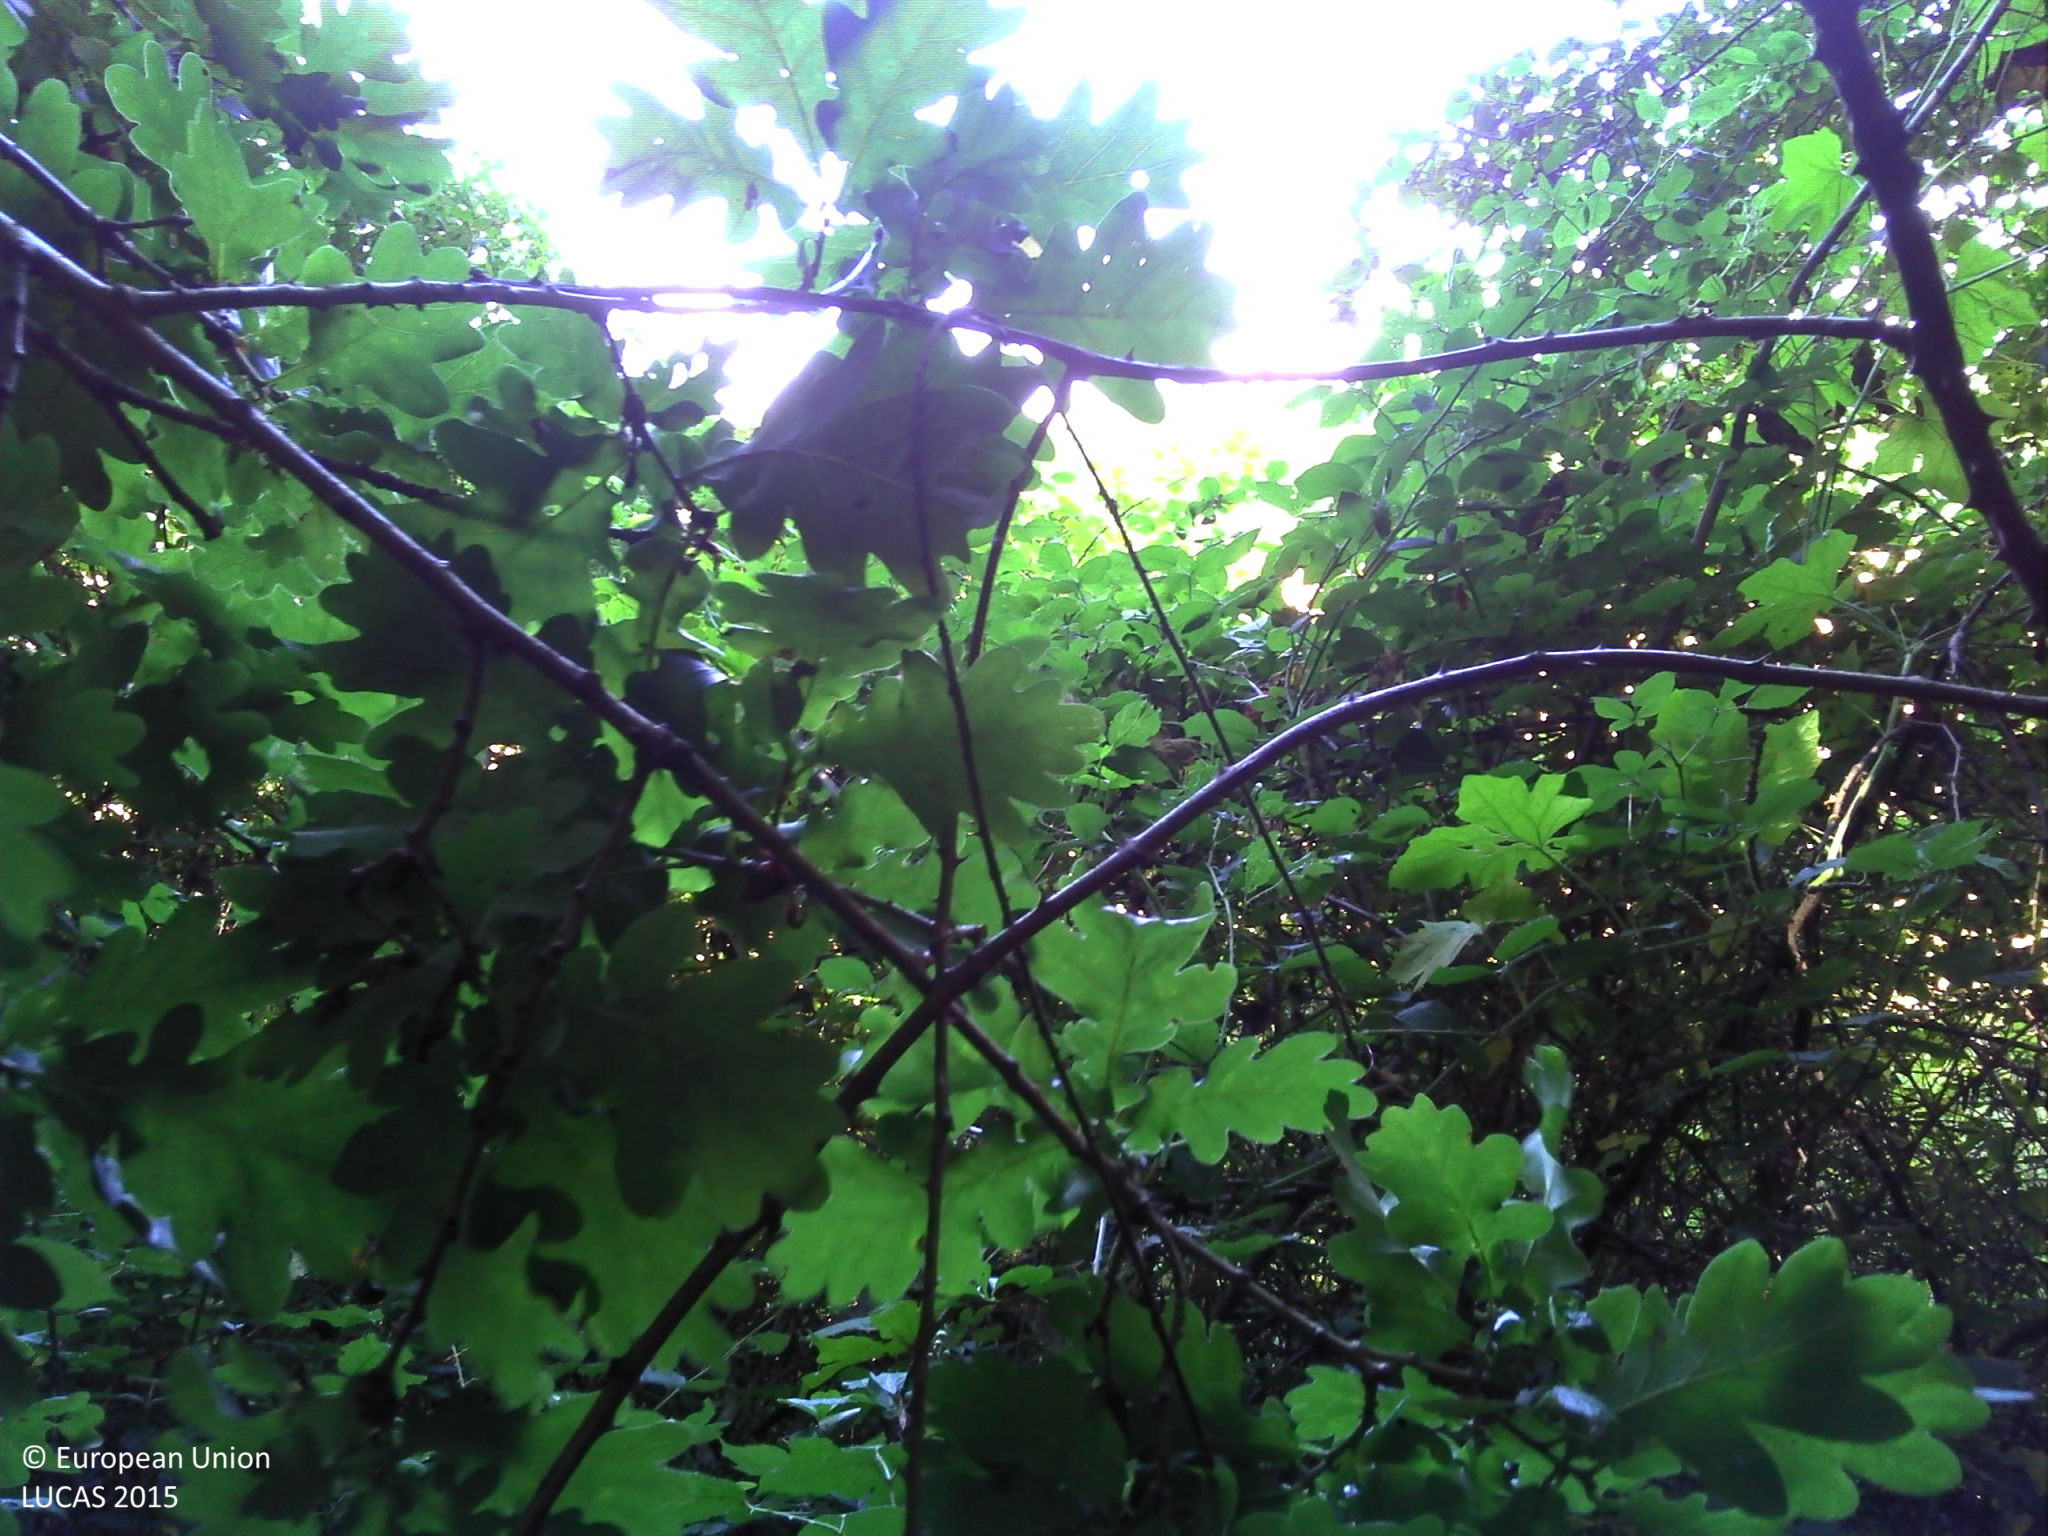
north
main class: Woodland
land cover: Broadleaved woodland
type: boreal forest
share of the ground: > 75 %
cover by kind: broadleaved forest trees 90 %, herbaceous plants 10 %
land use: Semi-natural and natural areas not in use
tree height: > 5 m
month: June
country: FR
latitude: 45.6132
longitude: 0.4326
